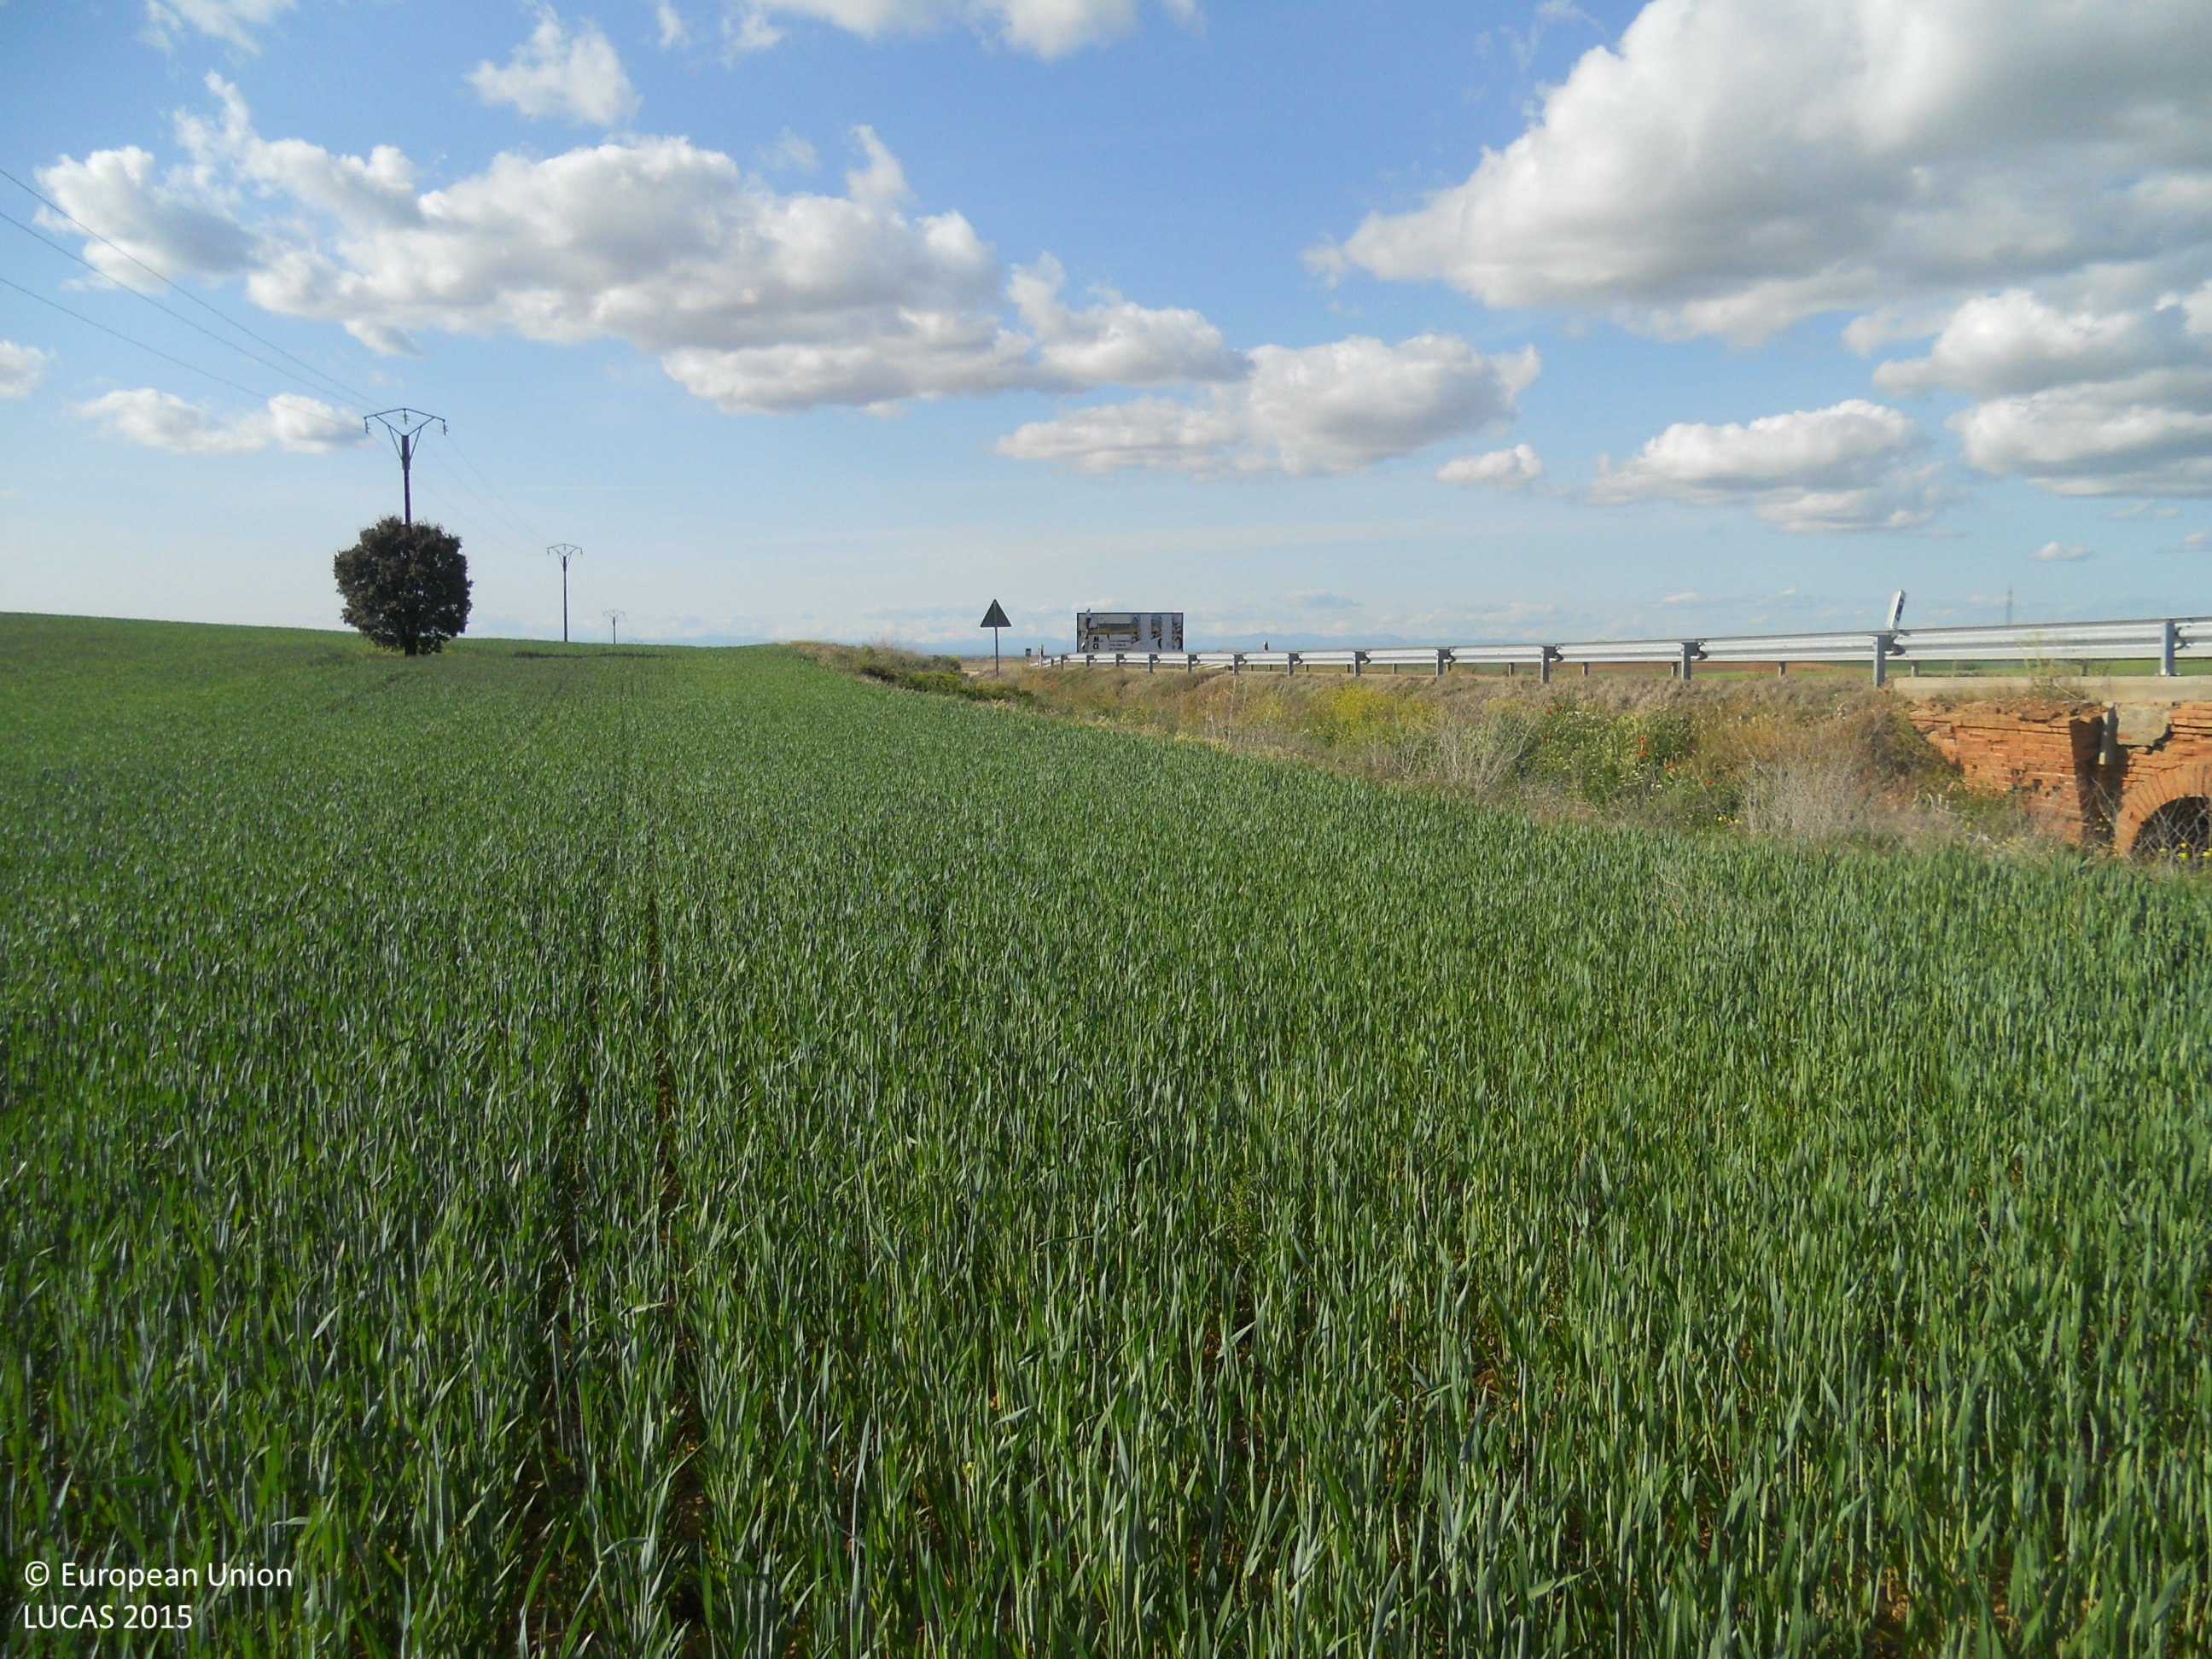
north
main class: Cropland
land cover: Common wheat
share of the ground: > 75 %
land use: Agriculture (excluding fallow land and kitchen gardens)
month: May
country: ES
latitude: 42.2426
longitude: -5.4943
